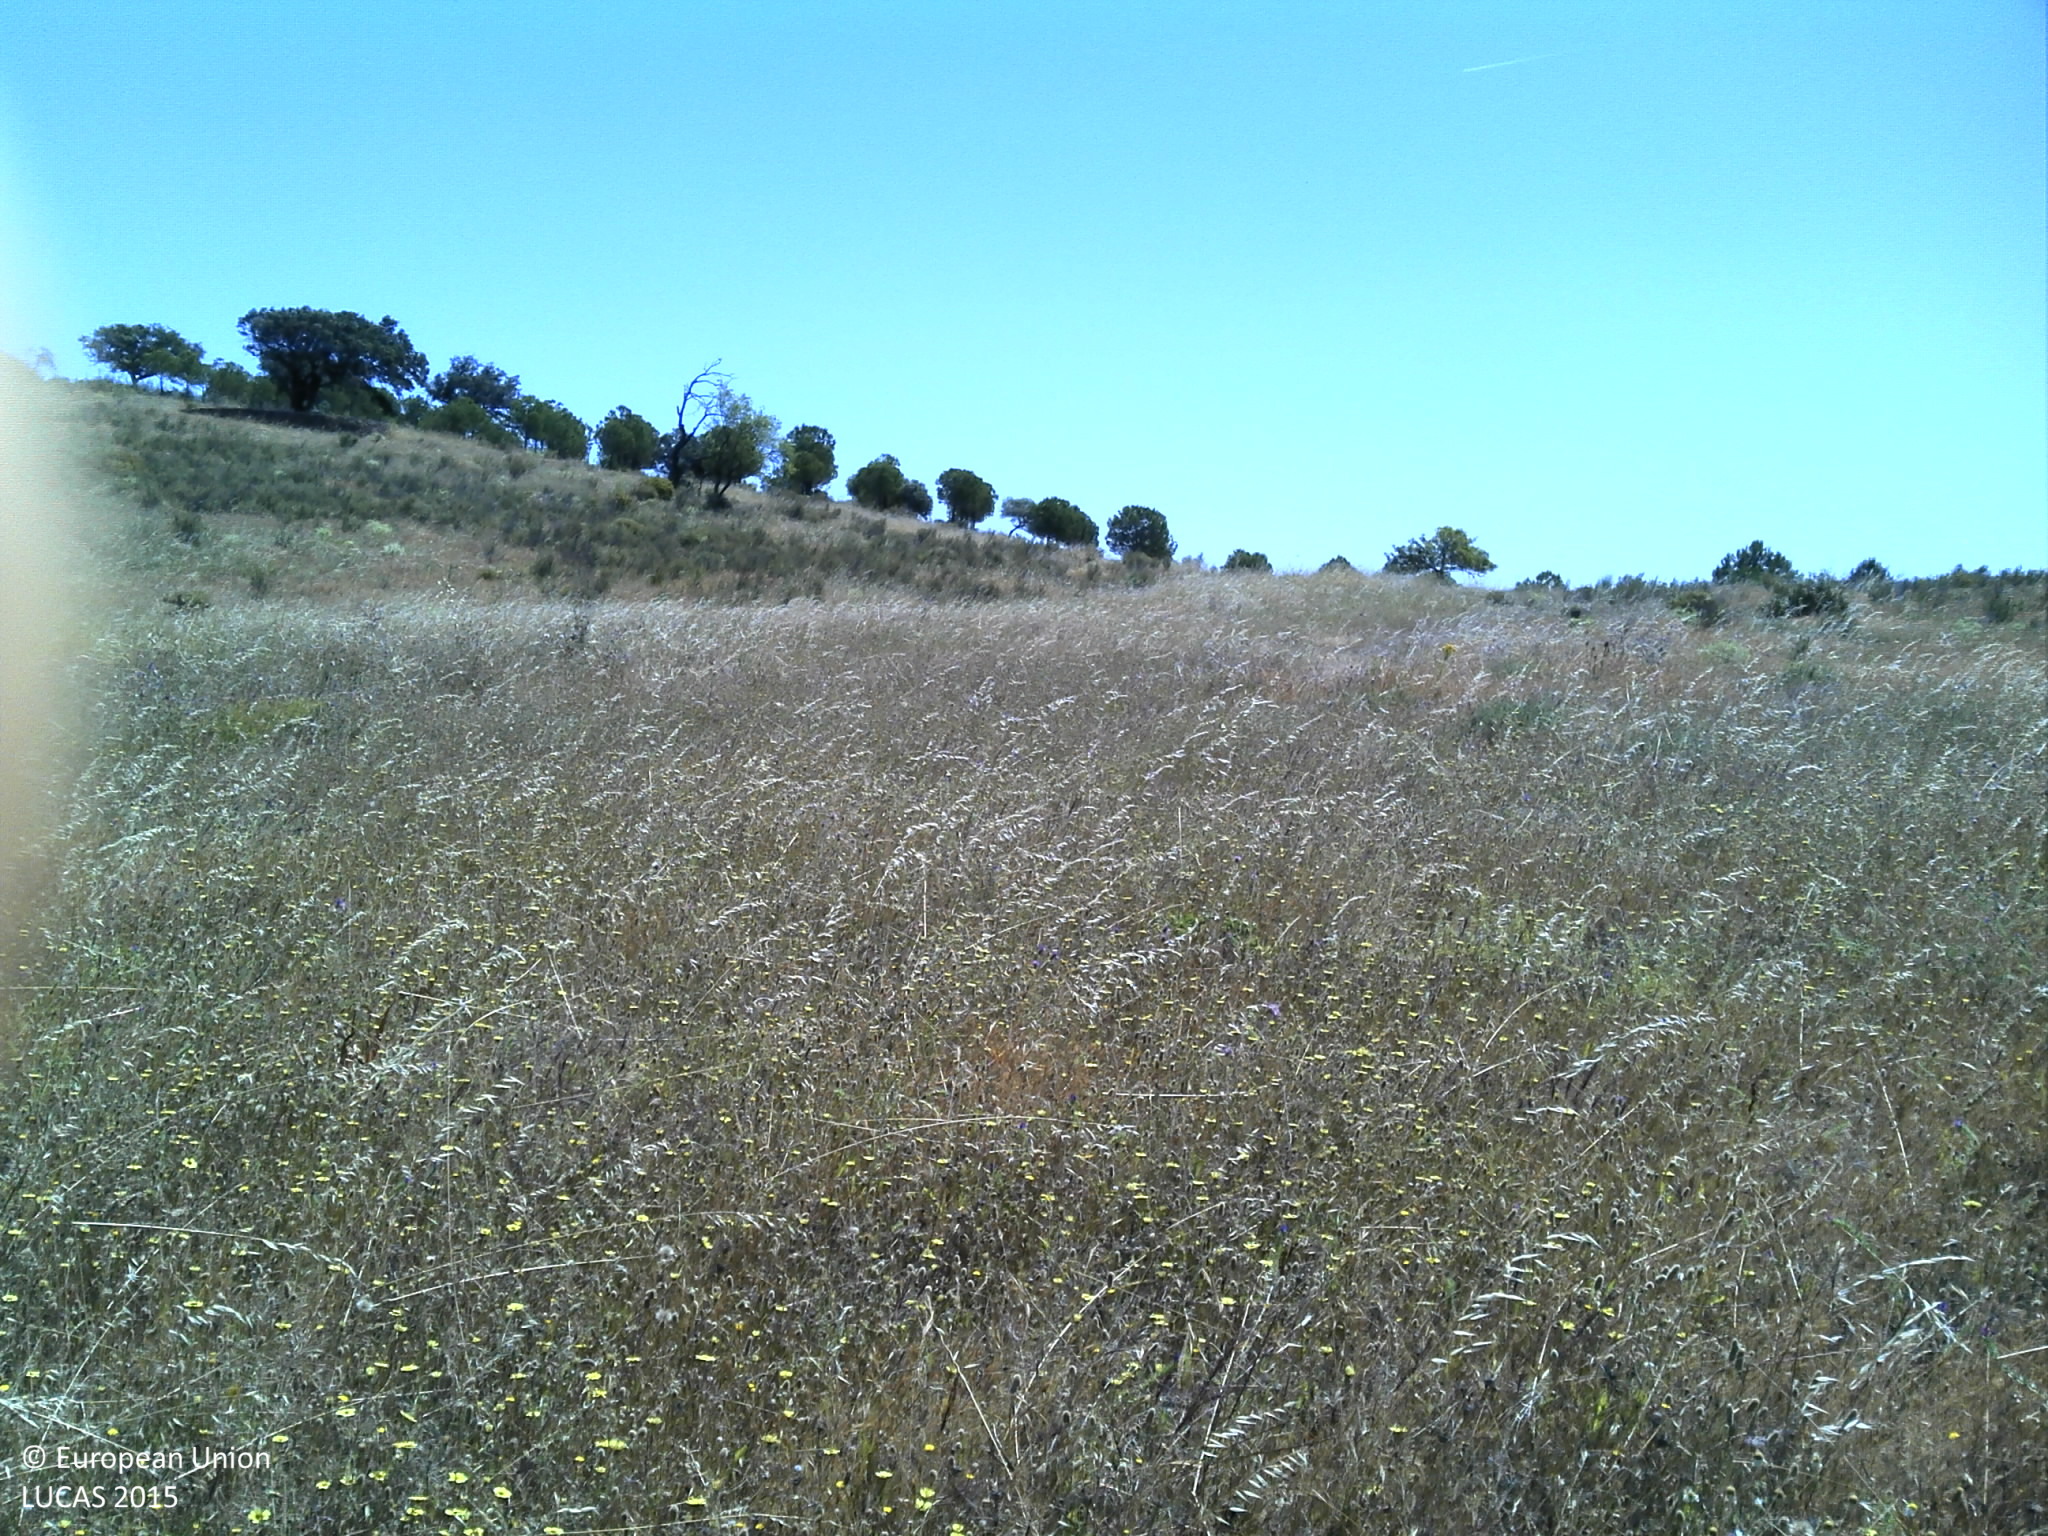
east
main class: Grassland
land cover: Grassland without tree/shrub cover
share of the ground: > 75 %
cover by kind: herbaceous plants 100 %
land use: Agriculture (excluding fallow land and kitchen gardens)
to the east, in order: Grassland without tree/shrub cover; Pine dominated coniferous woodland; Dry stone walls; Shrubland without tree cover; Grassland without tree/shrub cover; Shrubland without tree cover; Grassland without tree/shrub cover
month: May
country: PT
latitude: 37.4221
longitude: -7.5113
